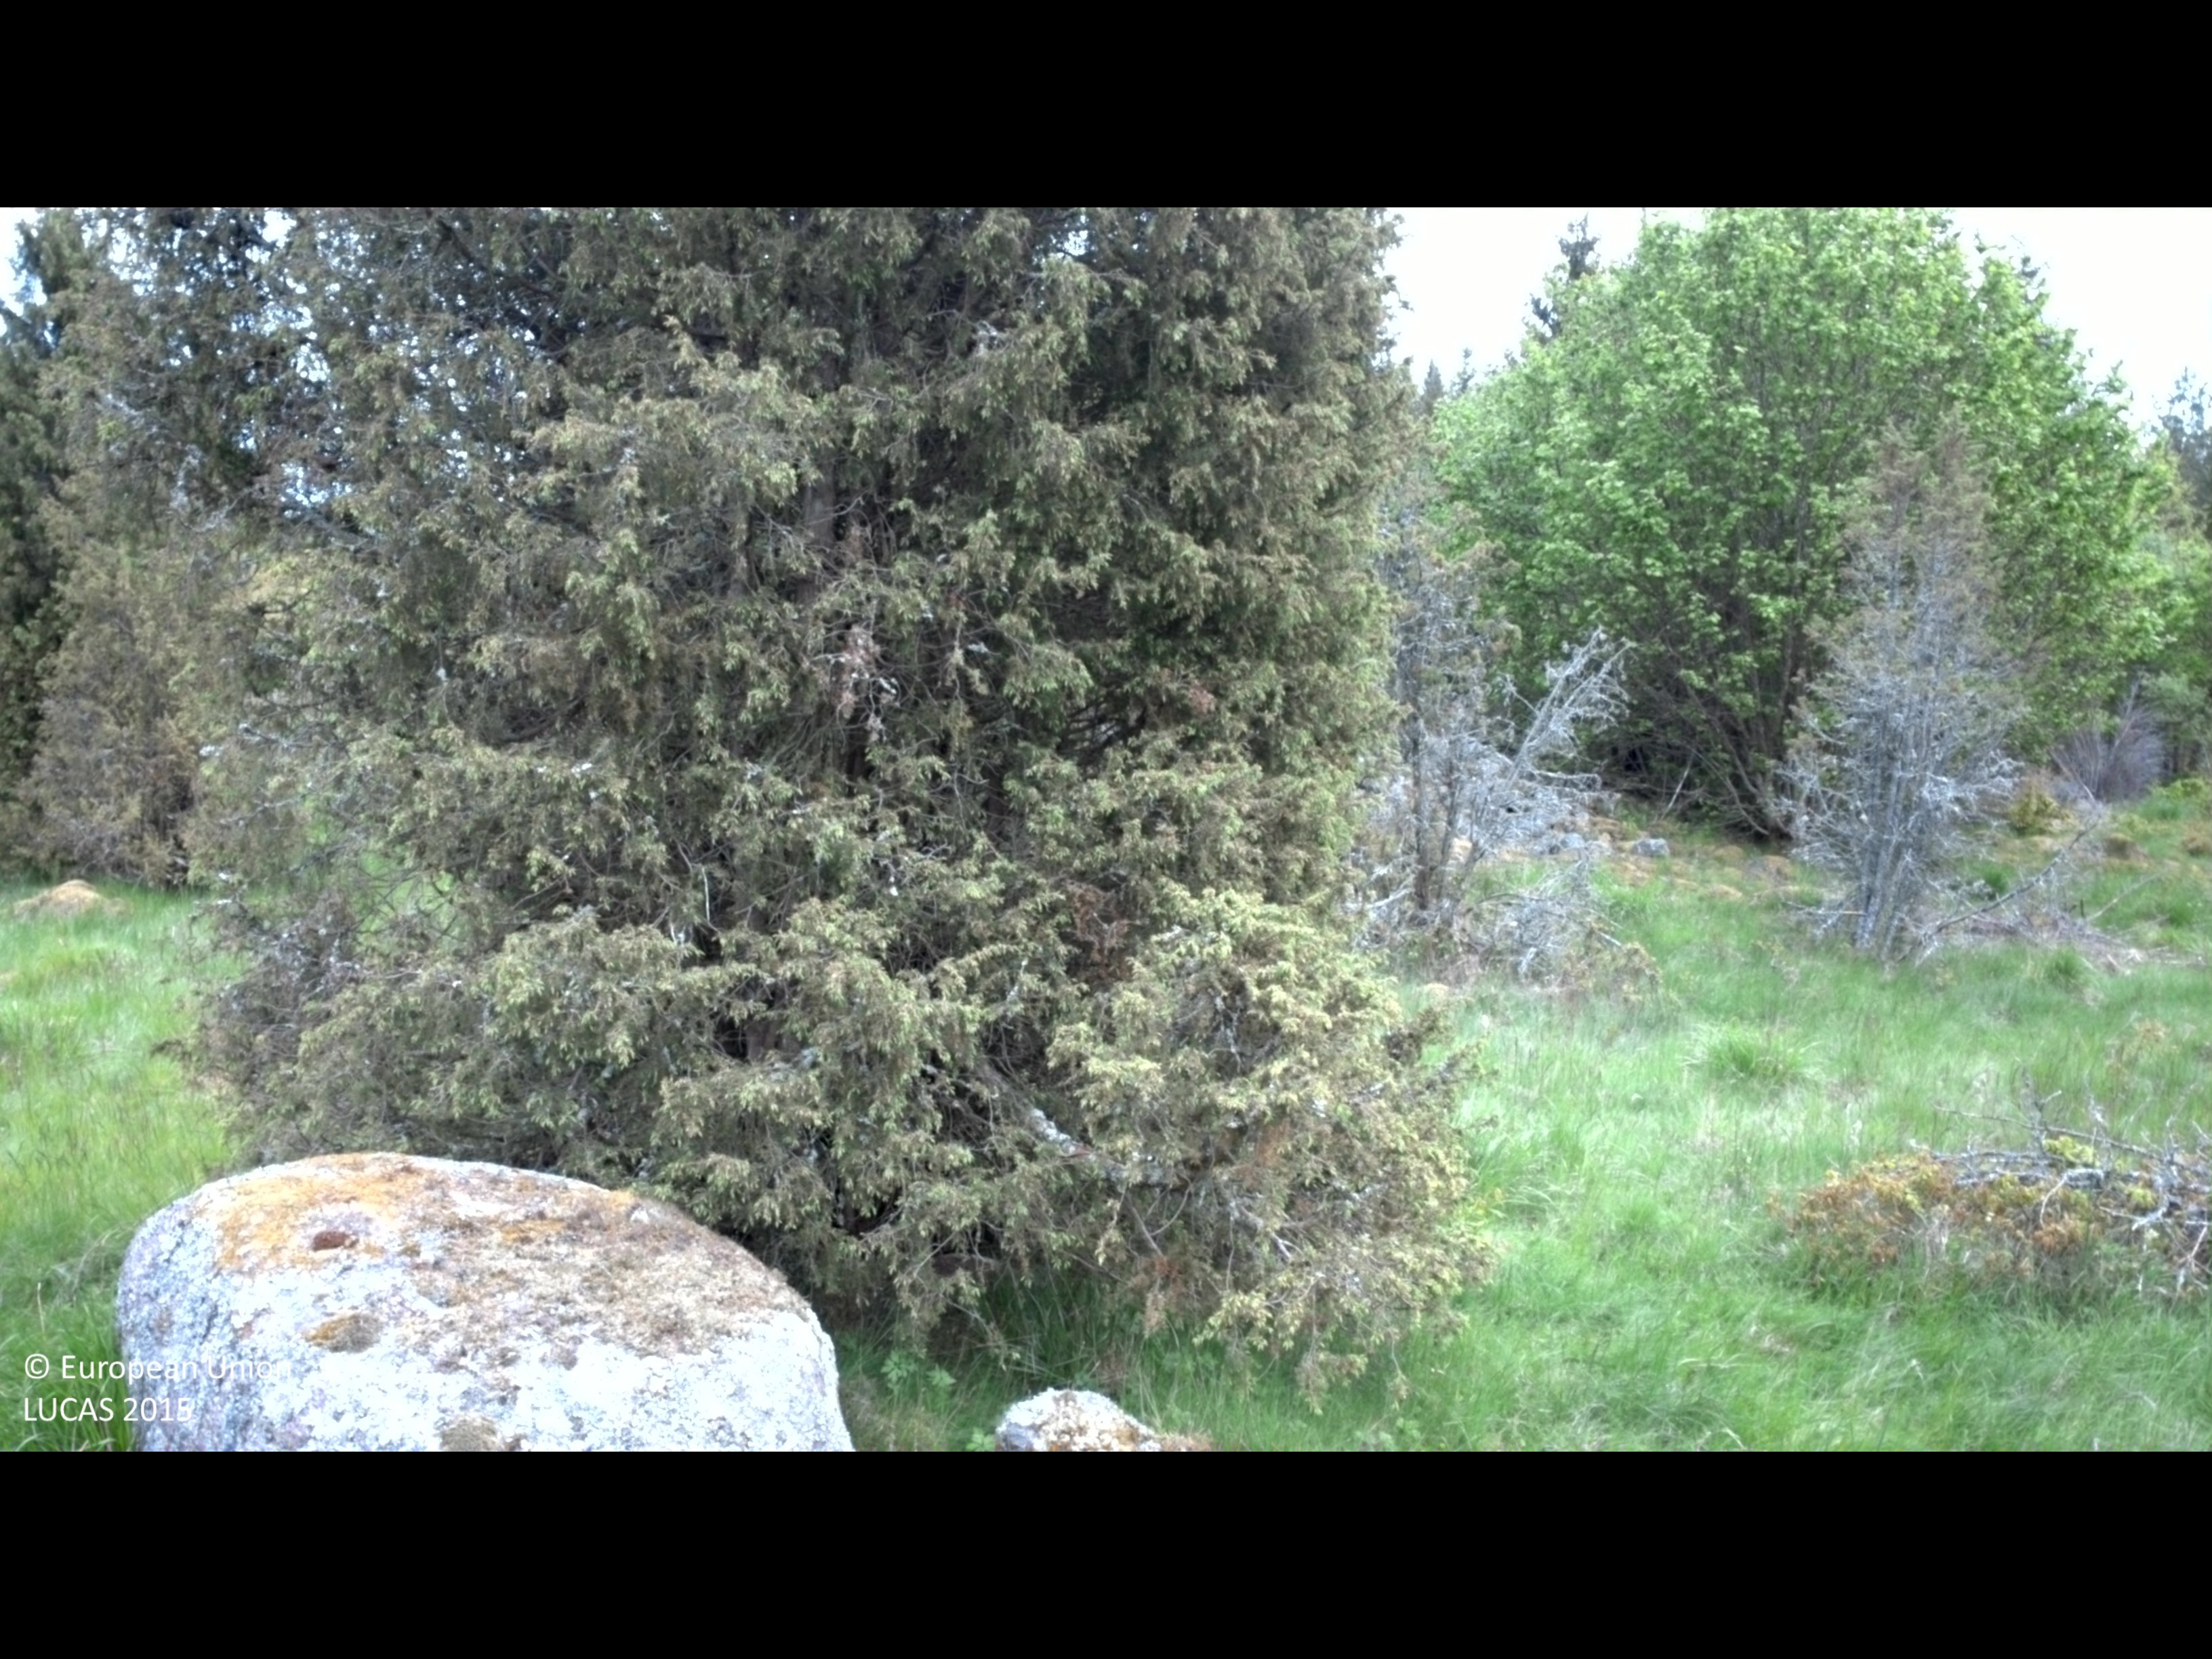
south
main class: Artificial land
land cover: Other artificial areas
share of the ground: > 75 %
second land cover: Grassland with sparse tree/shrub cover
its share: > 75 %
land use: Electricity, gas and thermal power distribution
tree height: > 5 m
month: June
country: SE
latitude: 57.7260
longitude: 16.3620
